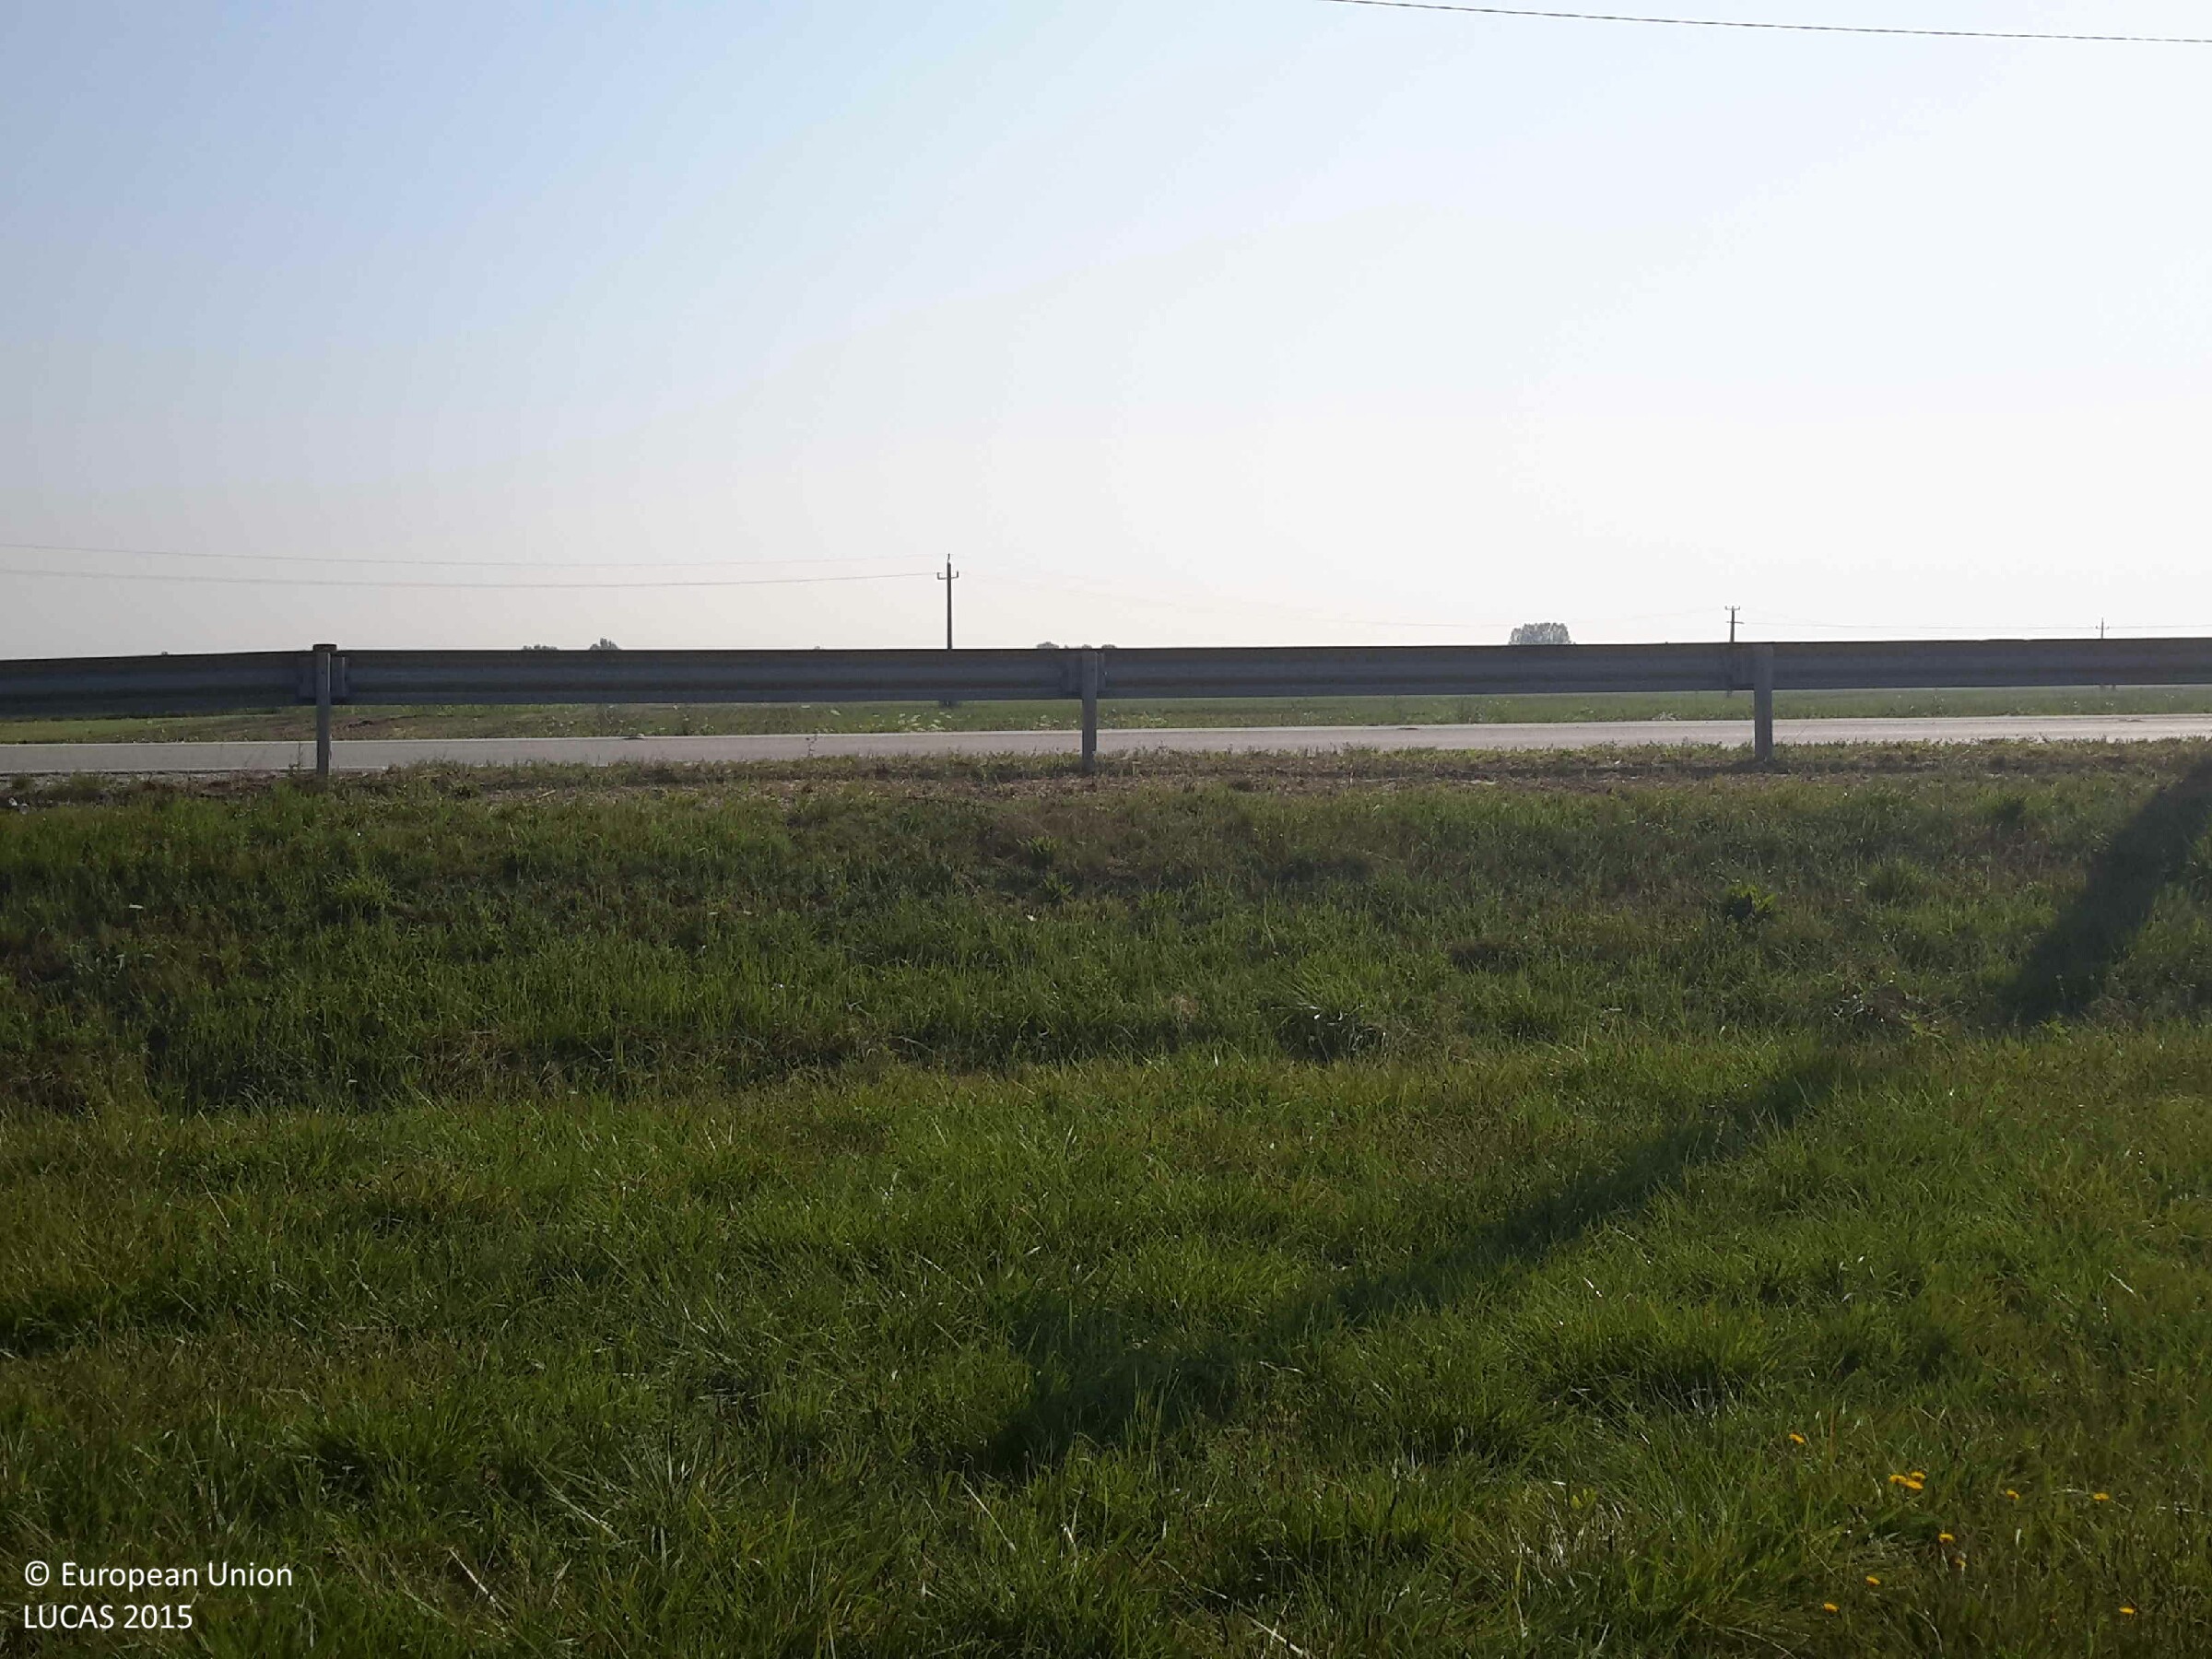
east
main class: Grassland
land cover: Grassland without tree/shrub cover
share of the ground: > 75 %
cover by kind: herbaceous plants 100 %
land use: Agriculture (excluding fallow land and kitchen gardens)
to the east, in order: Grassland without tree/shrub cover; Ditches and canals; Grass margins; Electric lines; Paved roads, cycling and walking lanes; Electric lines; Grass margins; Ditches and canals; Other bare soil
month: August
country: HU
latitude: 47.6961
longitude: 17.2427
